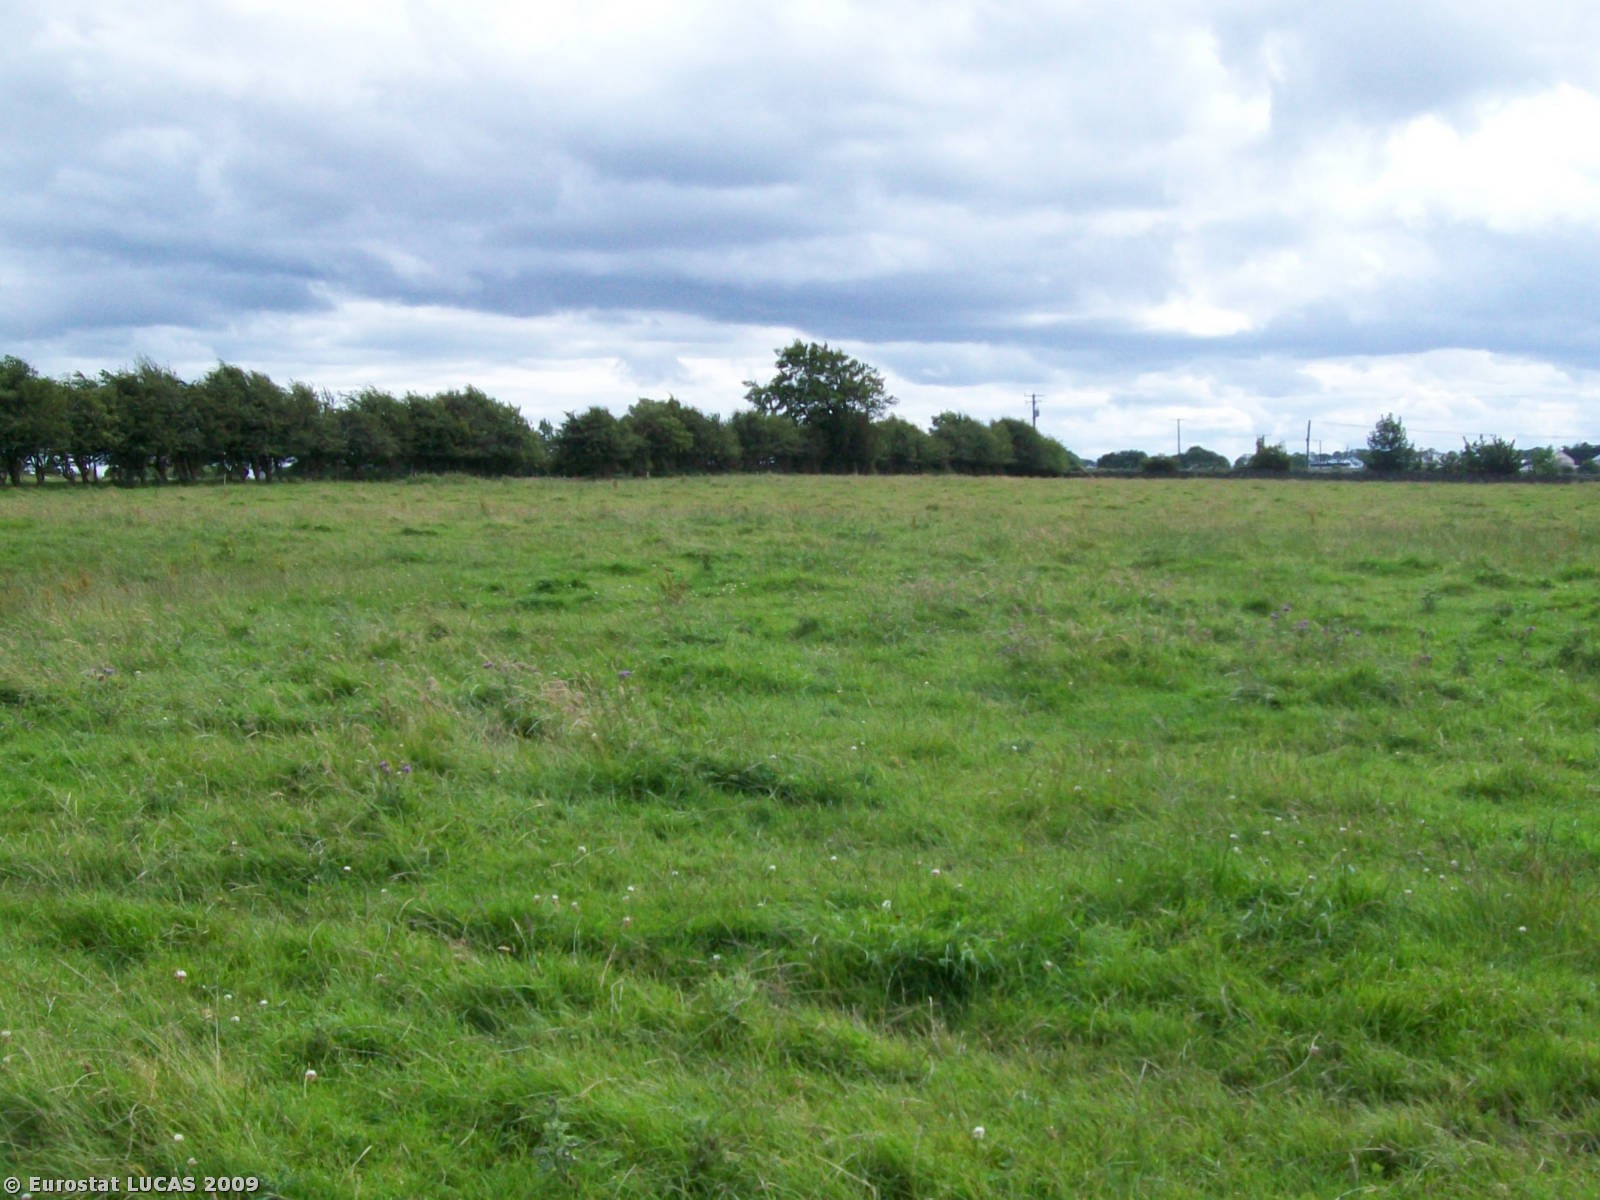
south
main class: Grassland
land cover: Grassland without tree/shrub cover
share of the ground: > 75 %
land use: Agriculture (excluding fallow land and kitchen gardens)
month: July
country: IE
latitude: 53.3147
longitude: -8.8023
